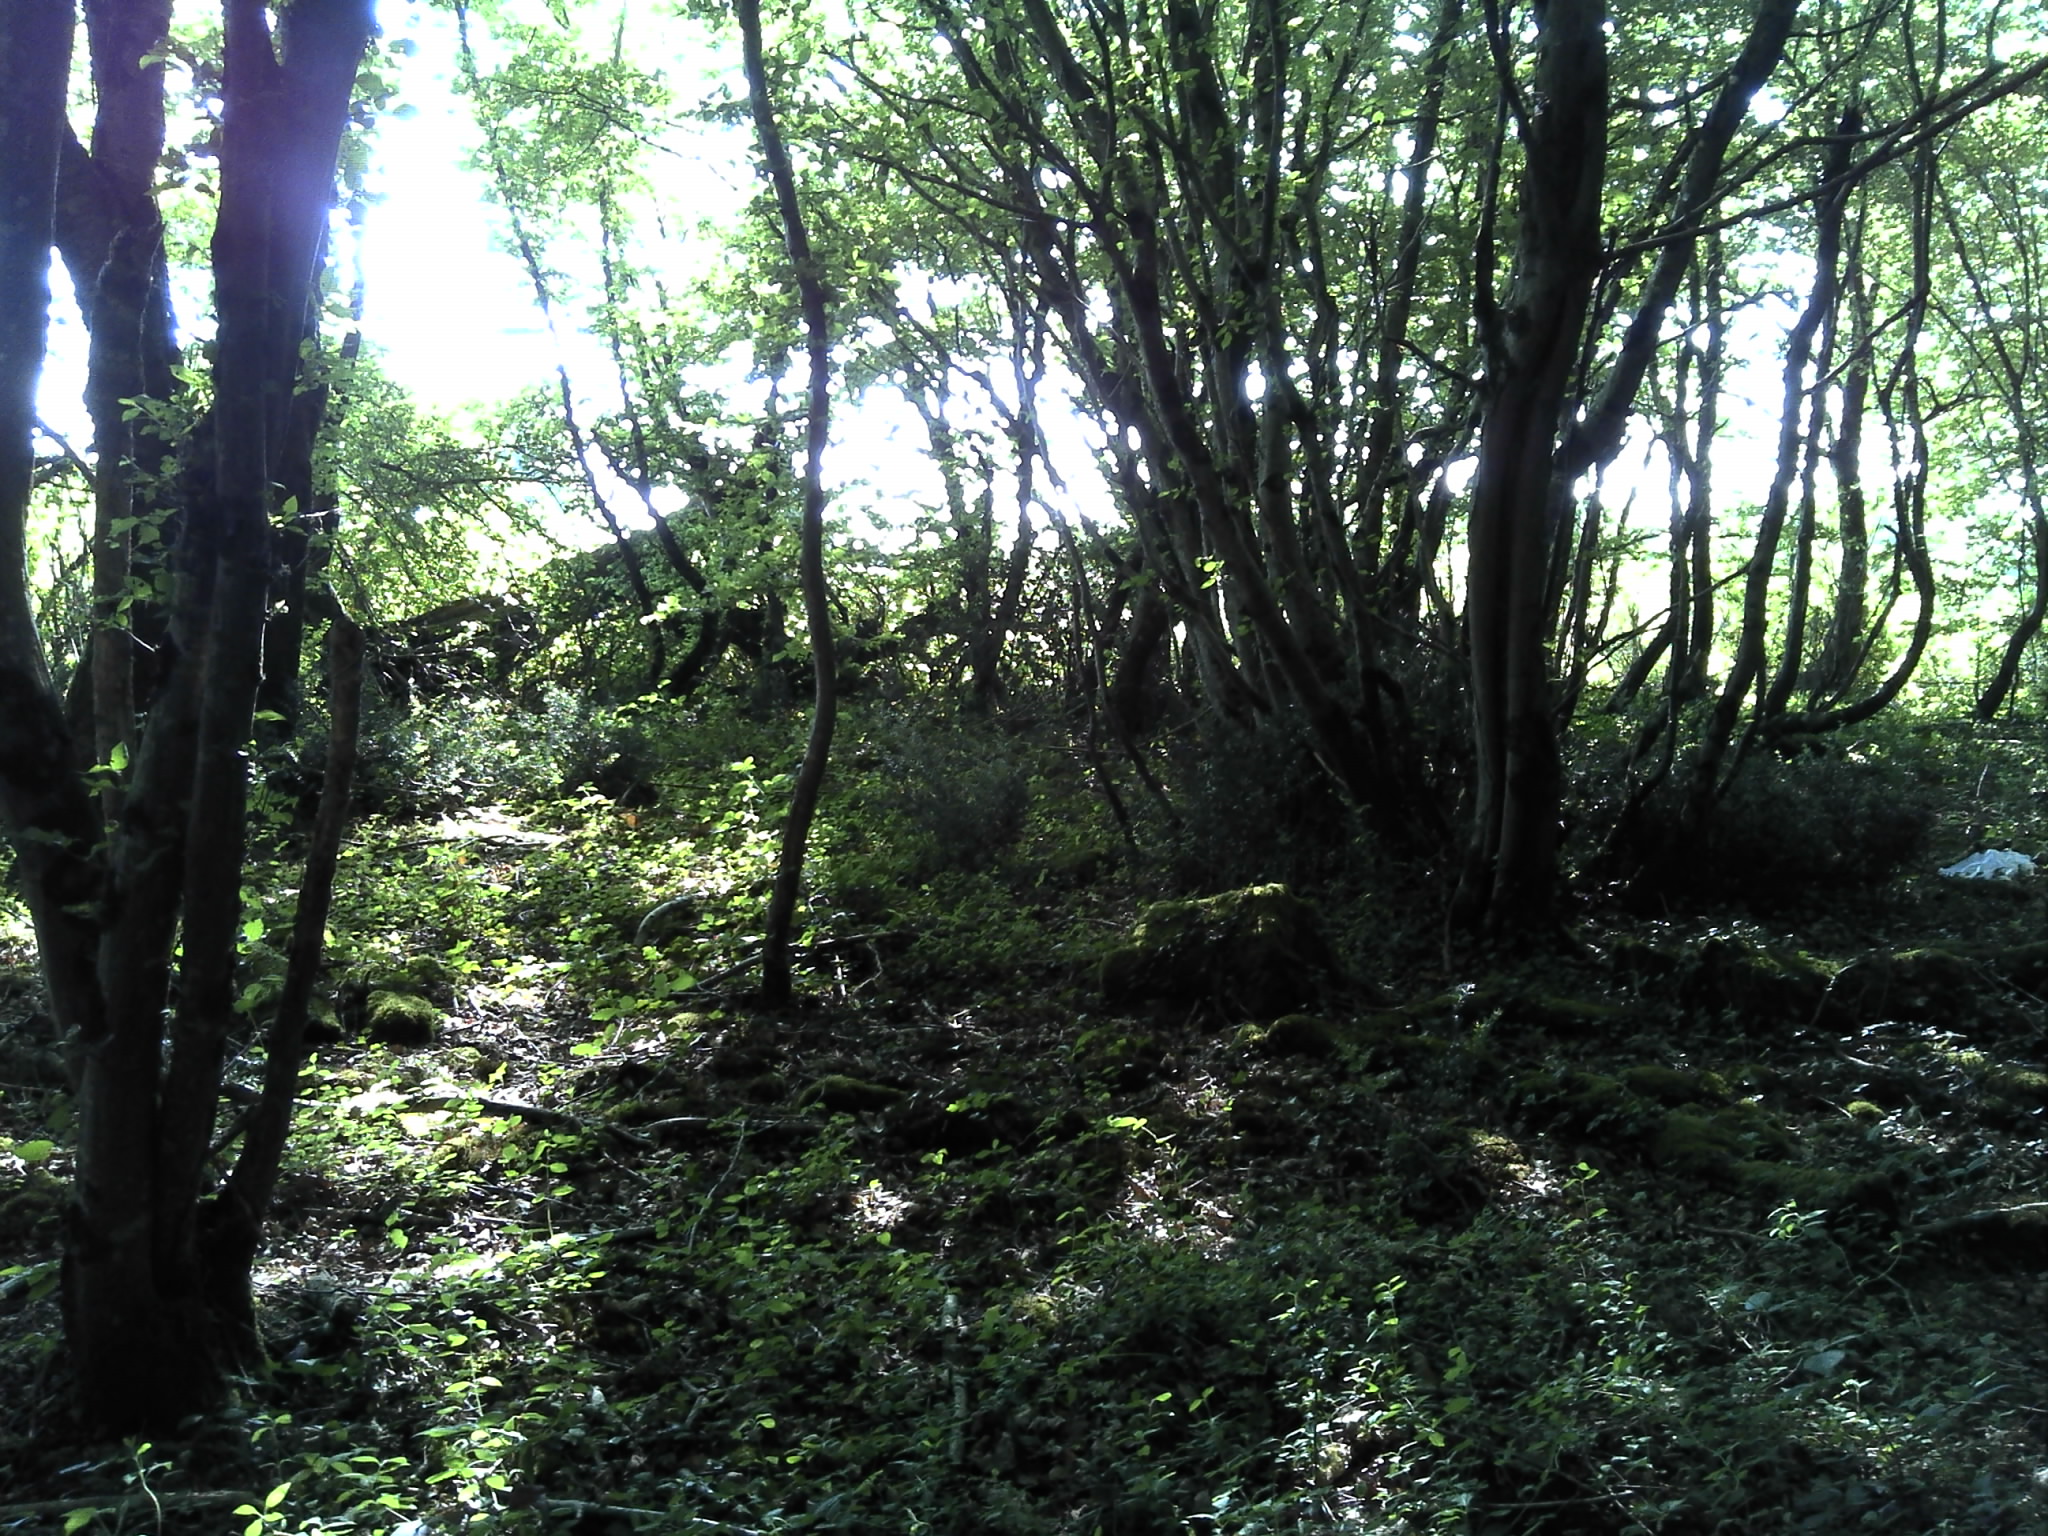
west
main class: Woodland
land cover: Broadleaved woodland
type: mesophytic deciduous forest
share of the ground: > 75 %
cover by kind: broadleaved forest trees 90 %, herbaceous plants 10 %
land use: Forestry
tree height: > 5 m
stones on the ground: < 10 %
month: June
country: FR
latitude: 46.6054
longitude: 1.6740
